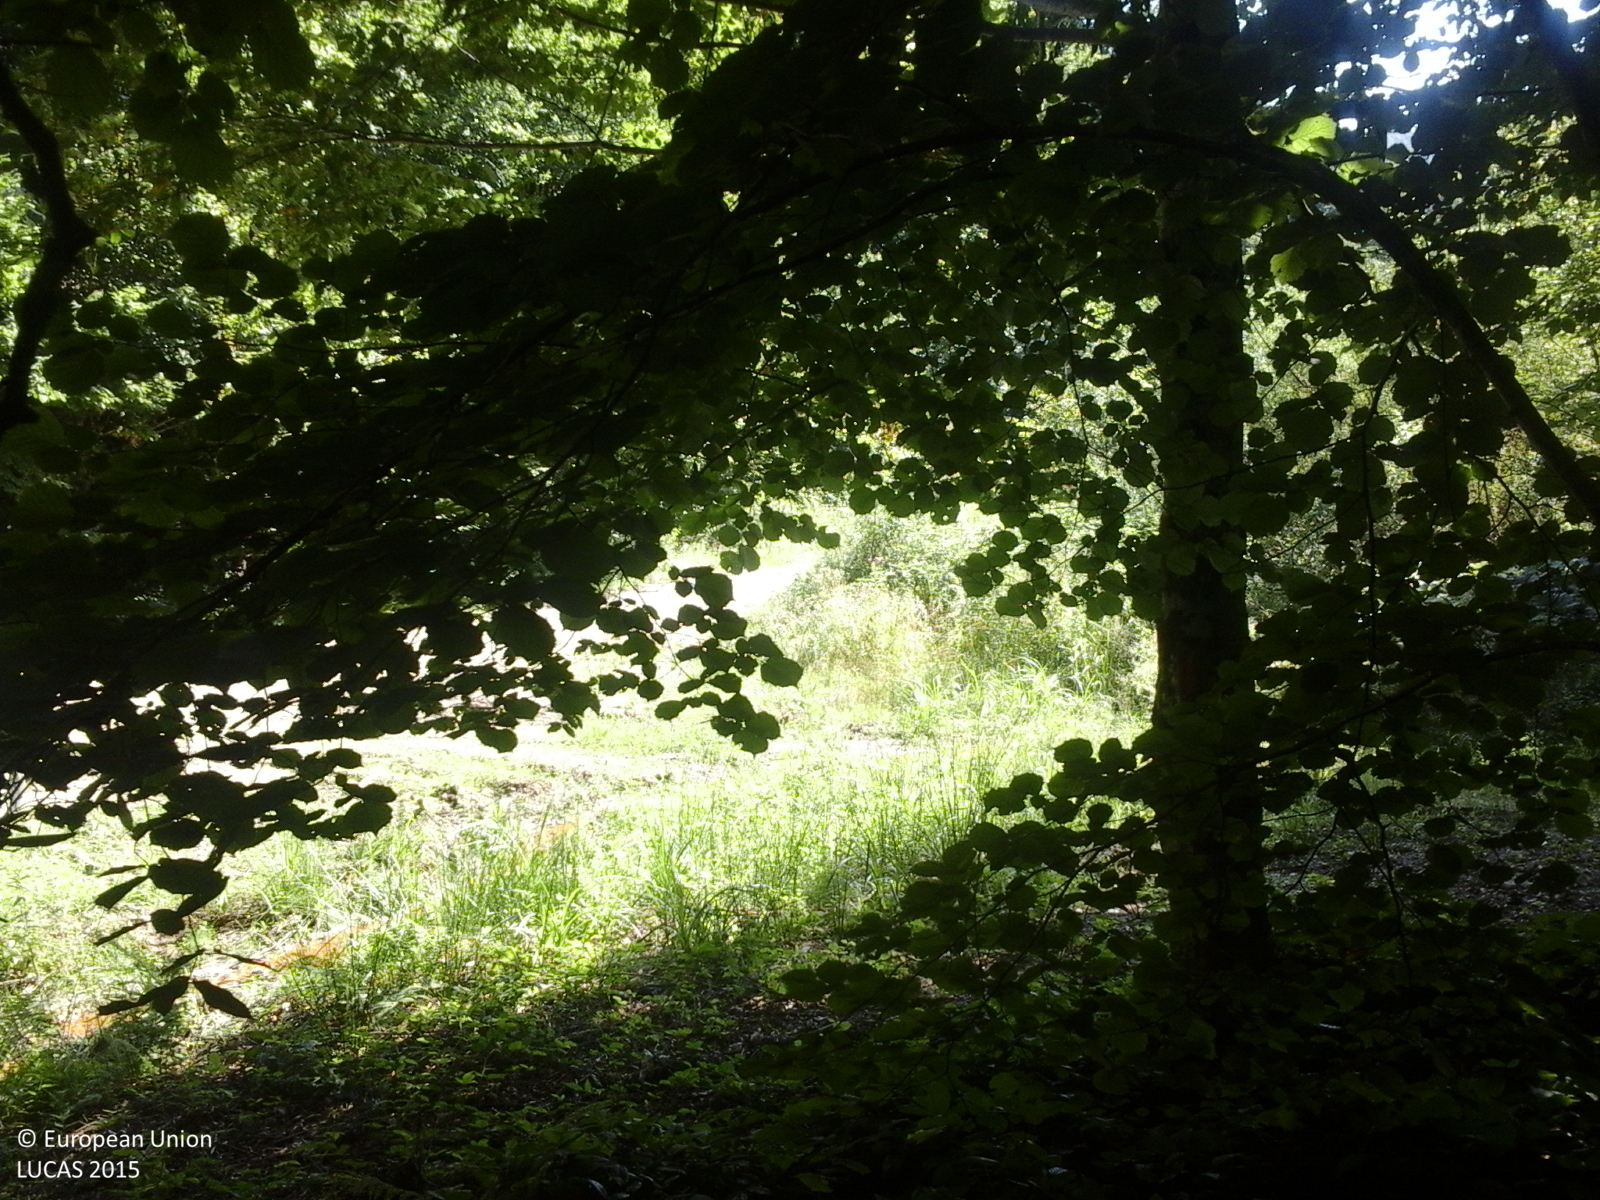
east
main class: Woodland
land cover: Broadleaved woodland
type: non-riverine alder, birch or aspen forest
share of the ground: > 75 %
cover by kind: broadleaved forest trees 100 %
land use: Forestry
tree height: > 5 m
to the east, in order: Broadleaved woodland; Rivers and streams; Tracks; Broadleaved woodland
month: August
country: RO
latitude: 46.4724
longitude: 22.3301
